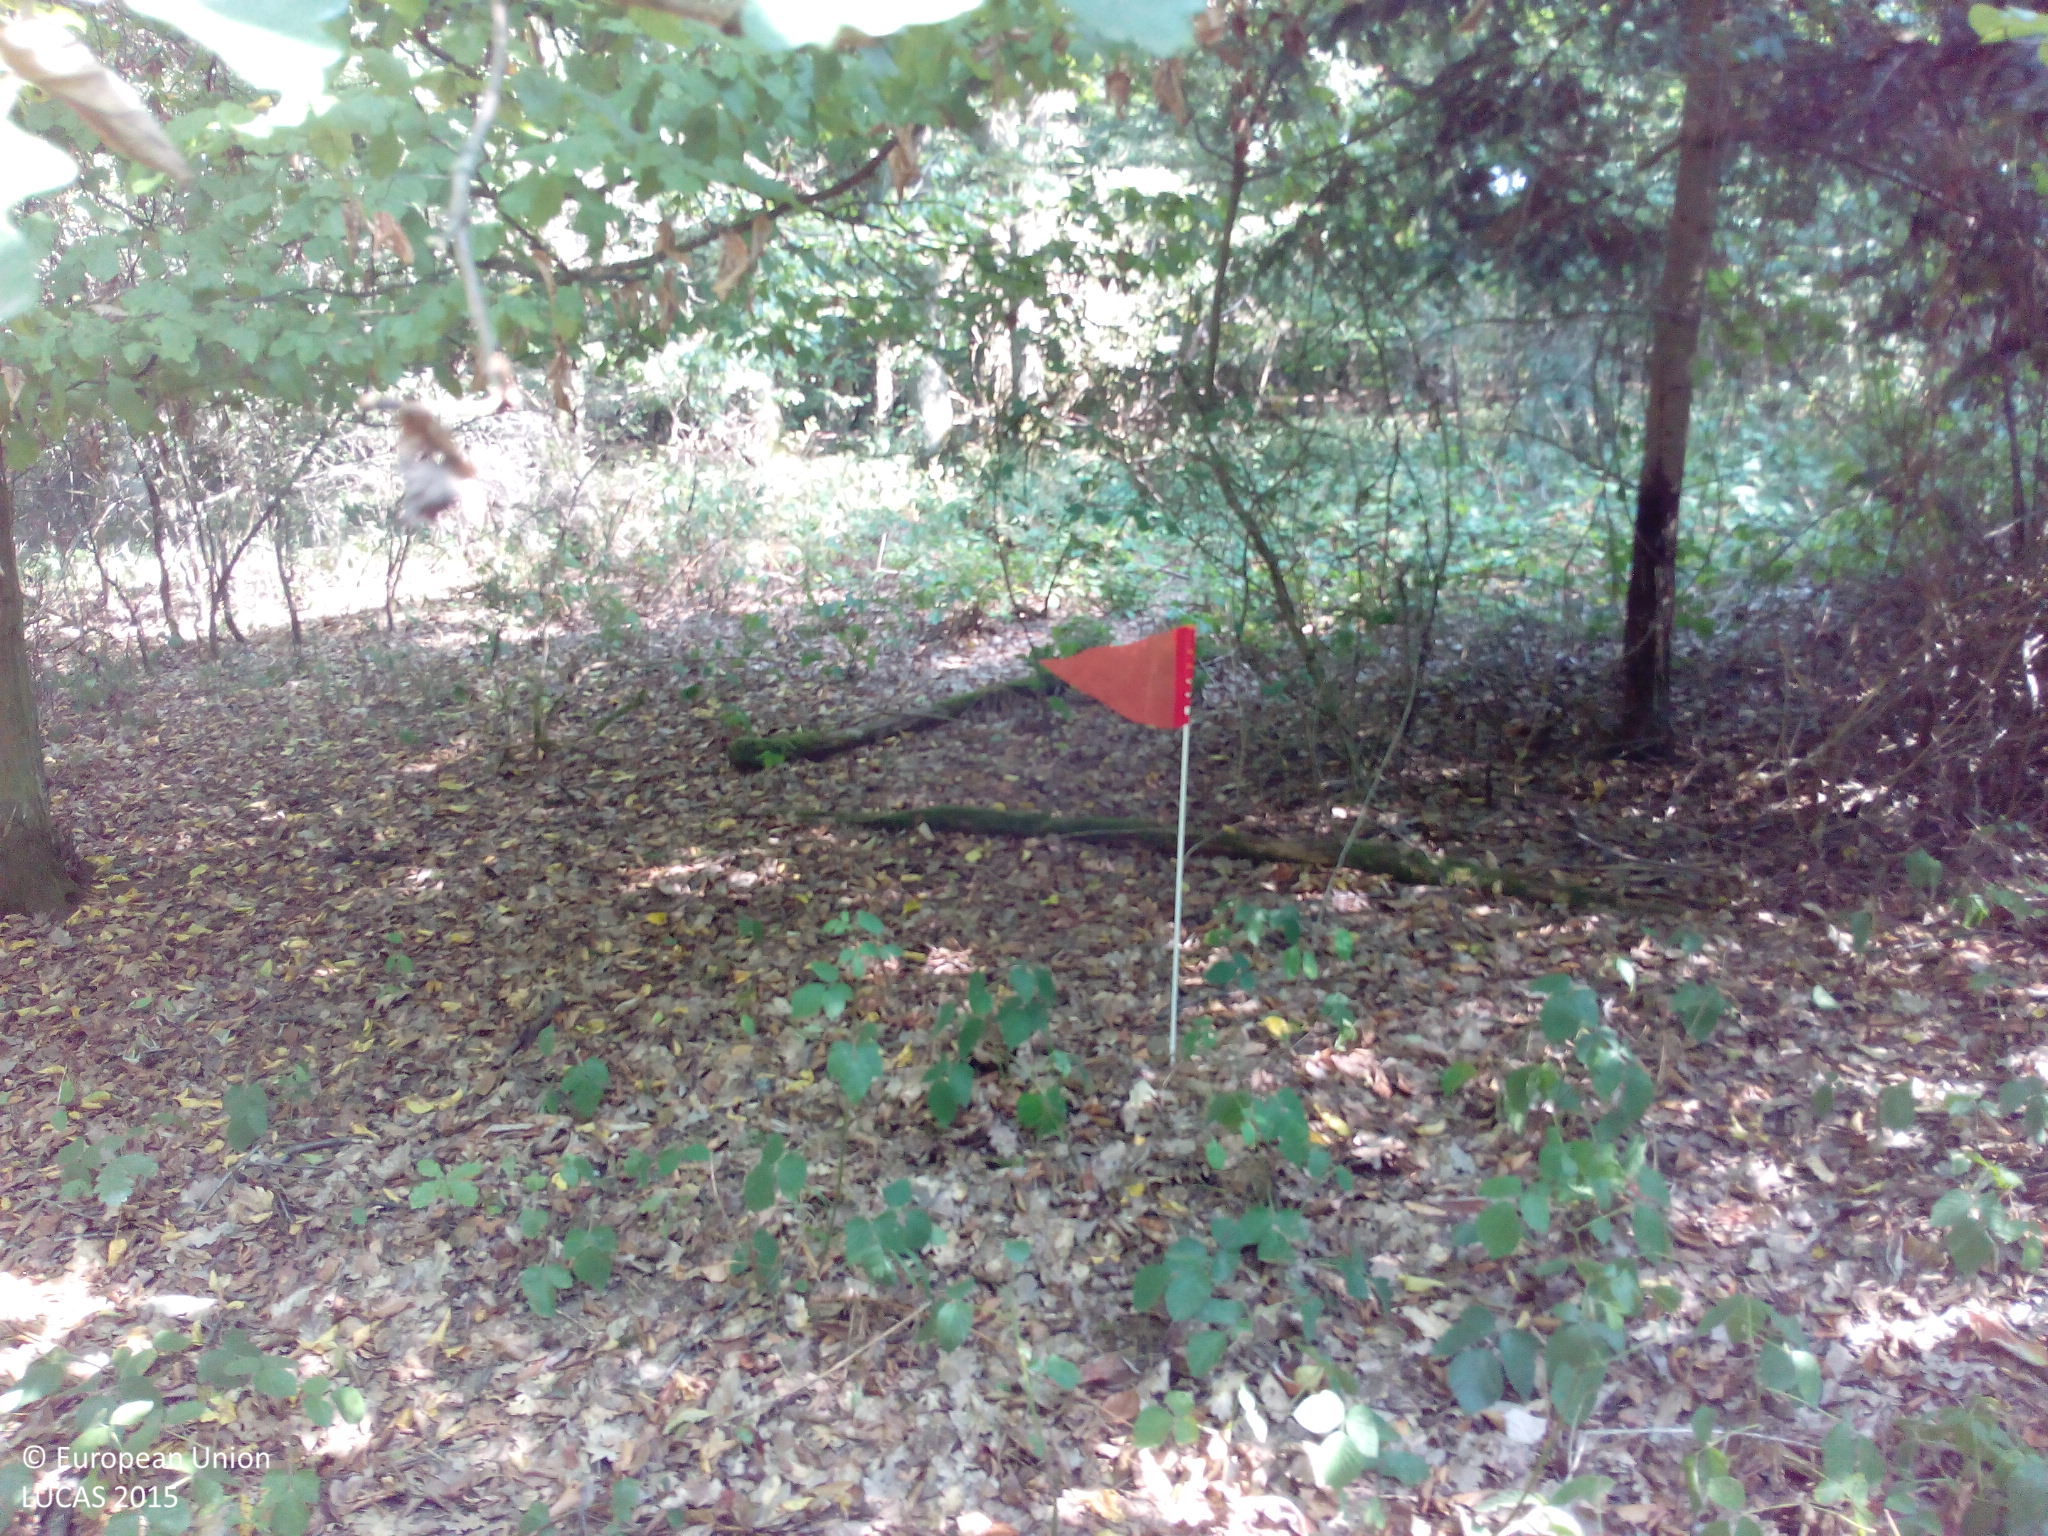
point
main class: Woodland
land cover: Broadleaved woodland
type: mesophytic deciduous forest
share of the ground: > 75 %
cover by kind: broadleaved forest trees 75 %, shrubs 10 %, unconsolidated bare surface 10 %, coniferous forest trees 5 %
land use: Forestry
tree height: > 5 m
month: August
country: DE
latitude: 50.1741
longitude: 7.4659
